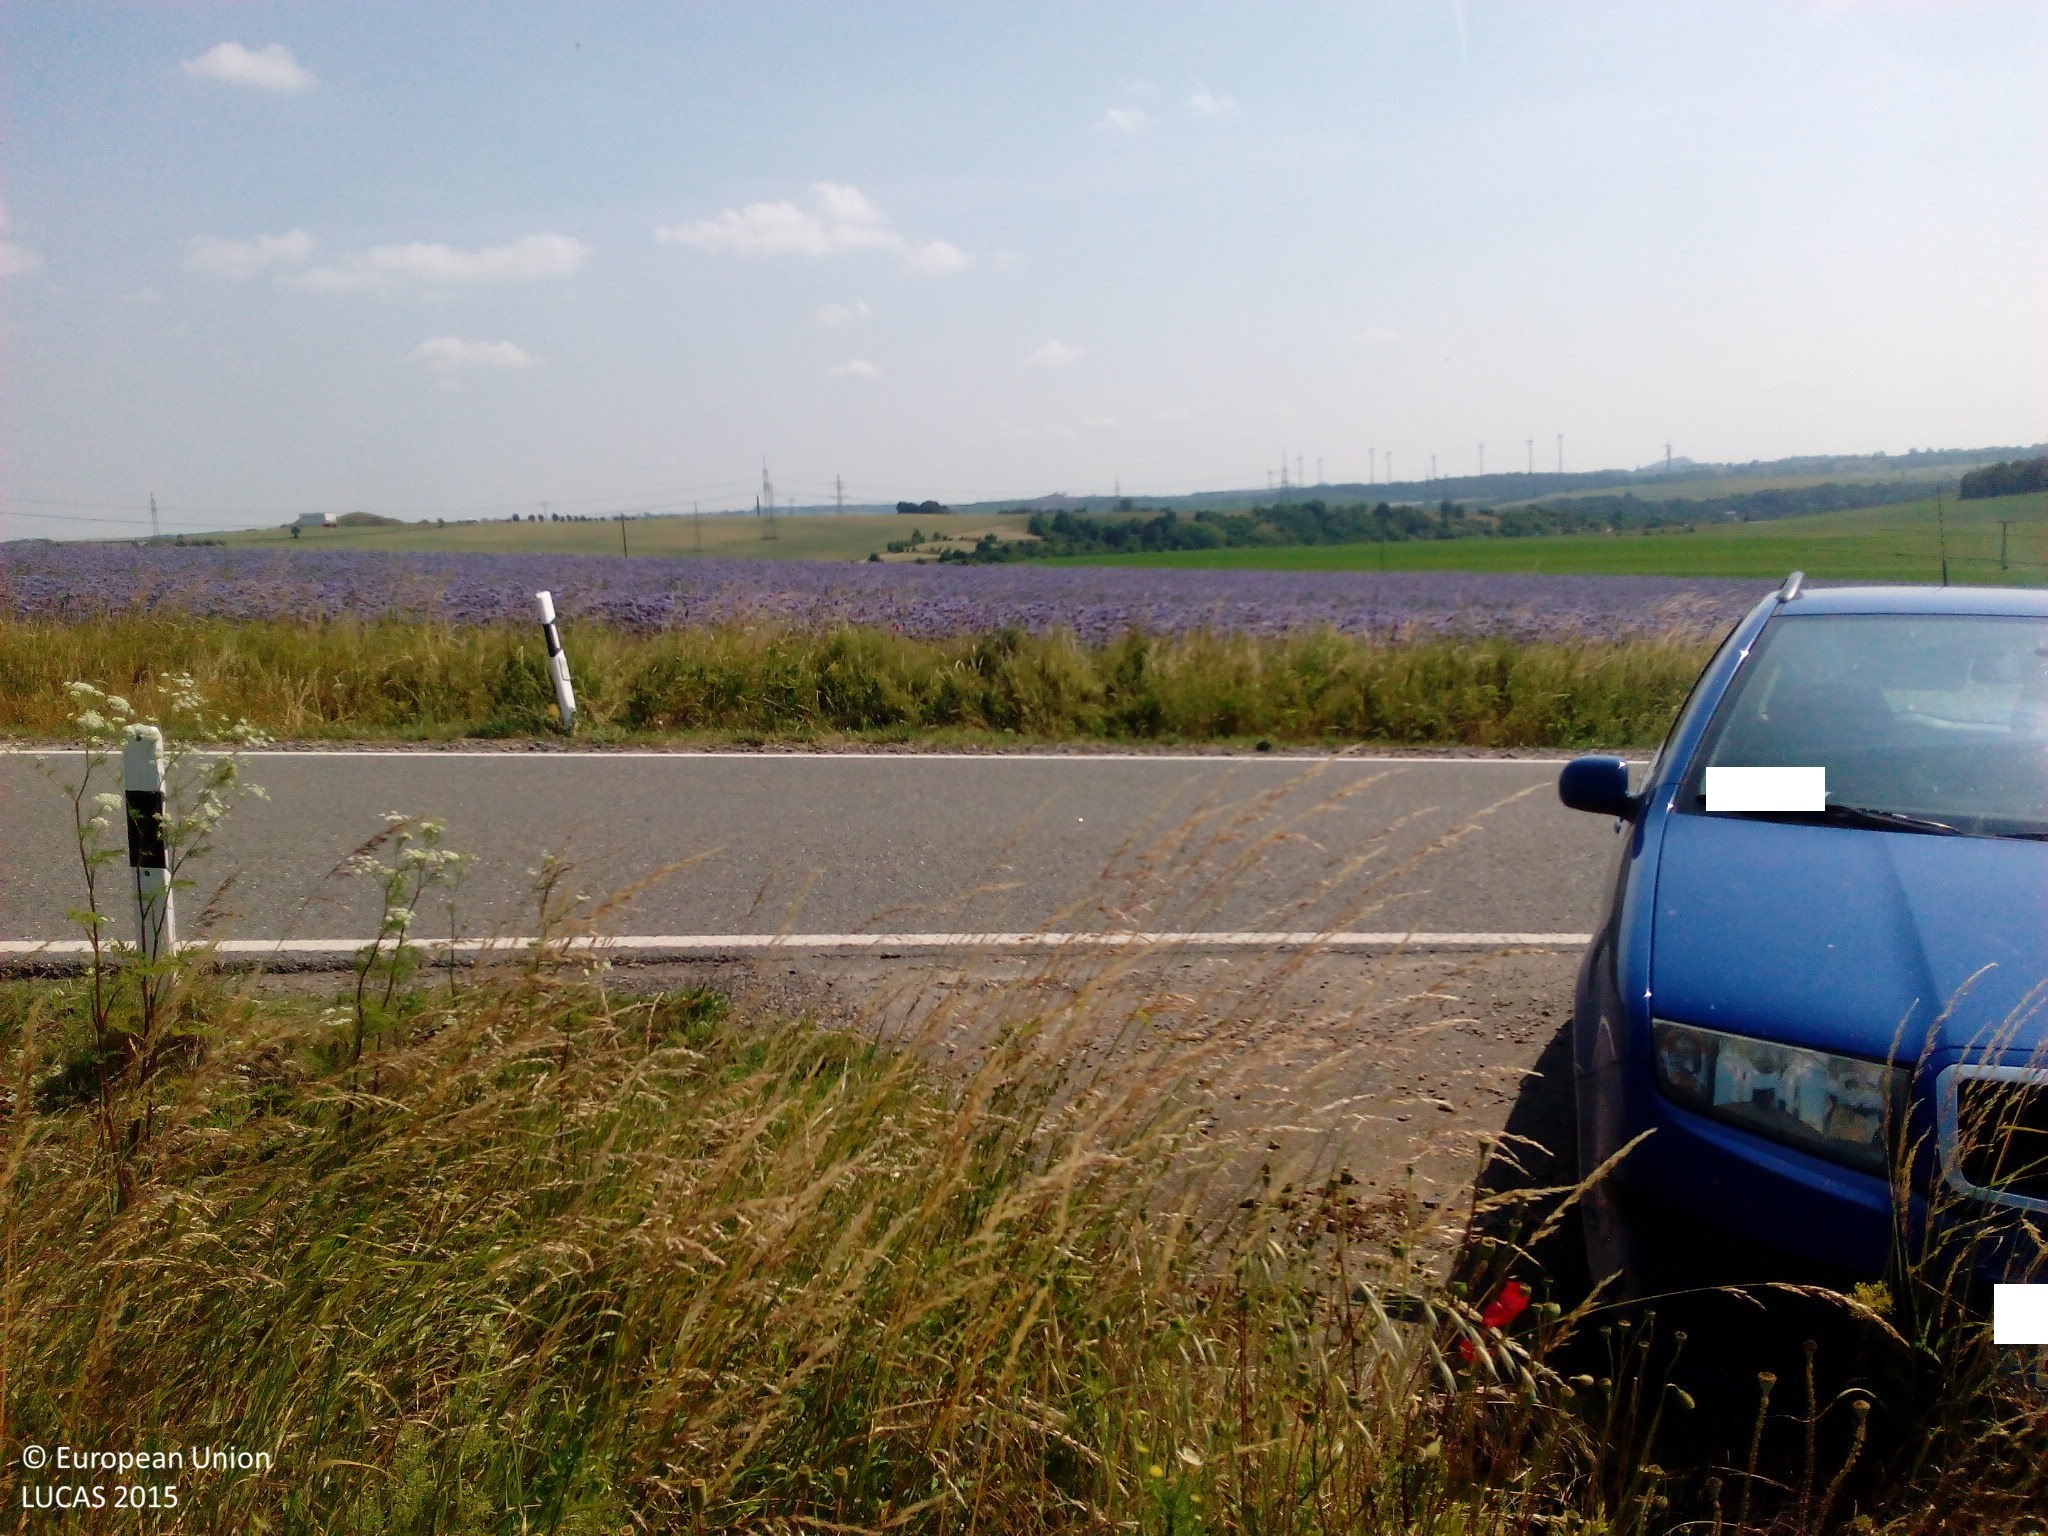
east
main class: Cropland
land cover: Maize
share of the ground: > 75 %
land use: Agriculture (excluding fallow land and kitchen gardens)
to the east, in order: Maize; Grass margins; Tracks; Grass margins; Other leguminous and mixtures for fodder; Sugar beet
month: June
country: DE
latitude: 51.6135
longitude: 11.4582
